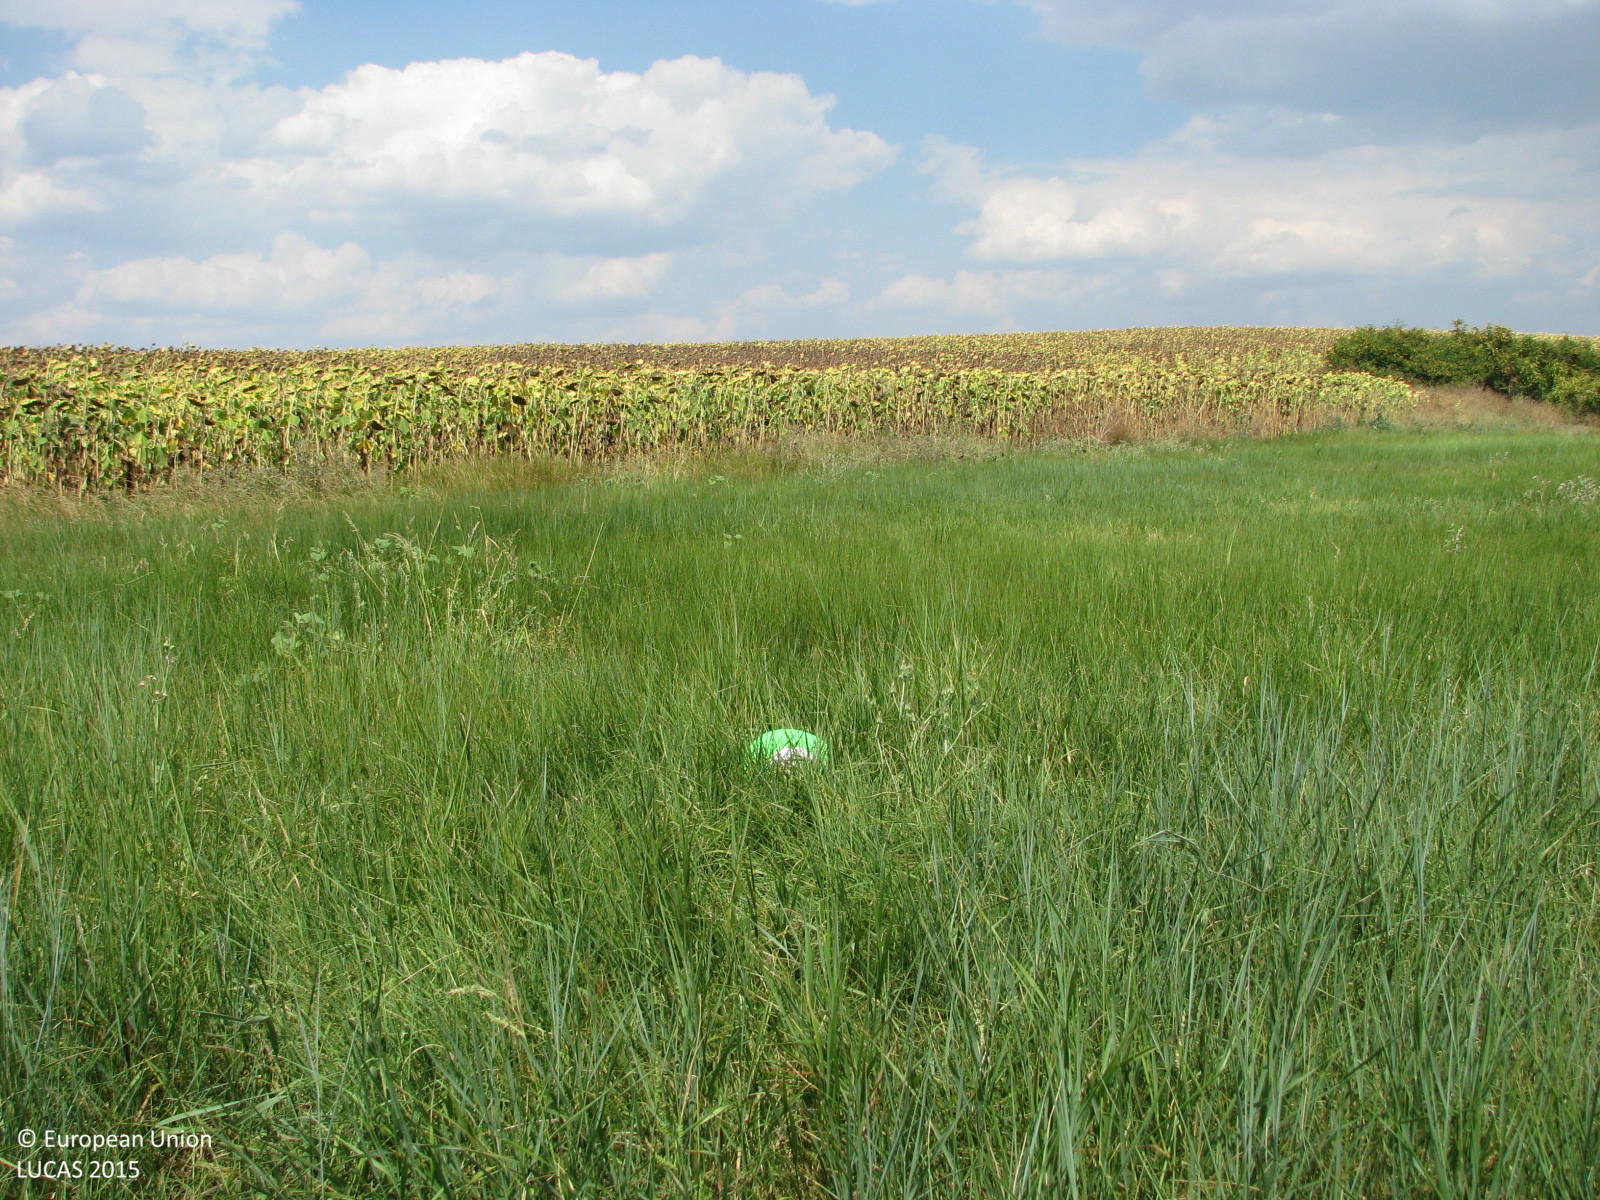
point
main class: Grassland
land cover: Grassland without tree/shrub cover
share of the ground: > 75 %
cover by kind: herbaceous plants 100 %
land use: Agriculture (excluding fallow land and kitchen gardens)
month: August
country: BG
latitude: 42.1482
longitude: 26.7568
